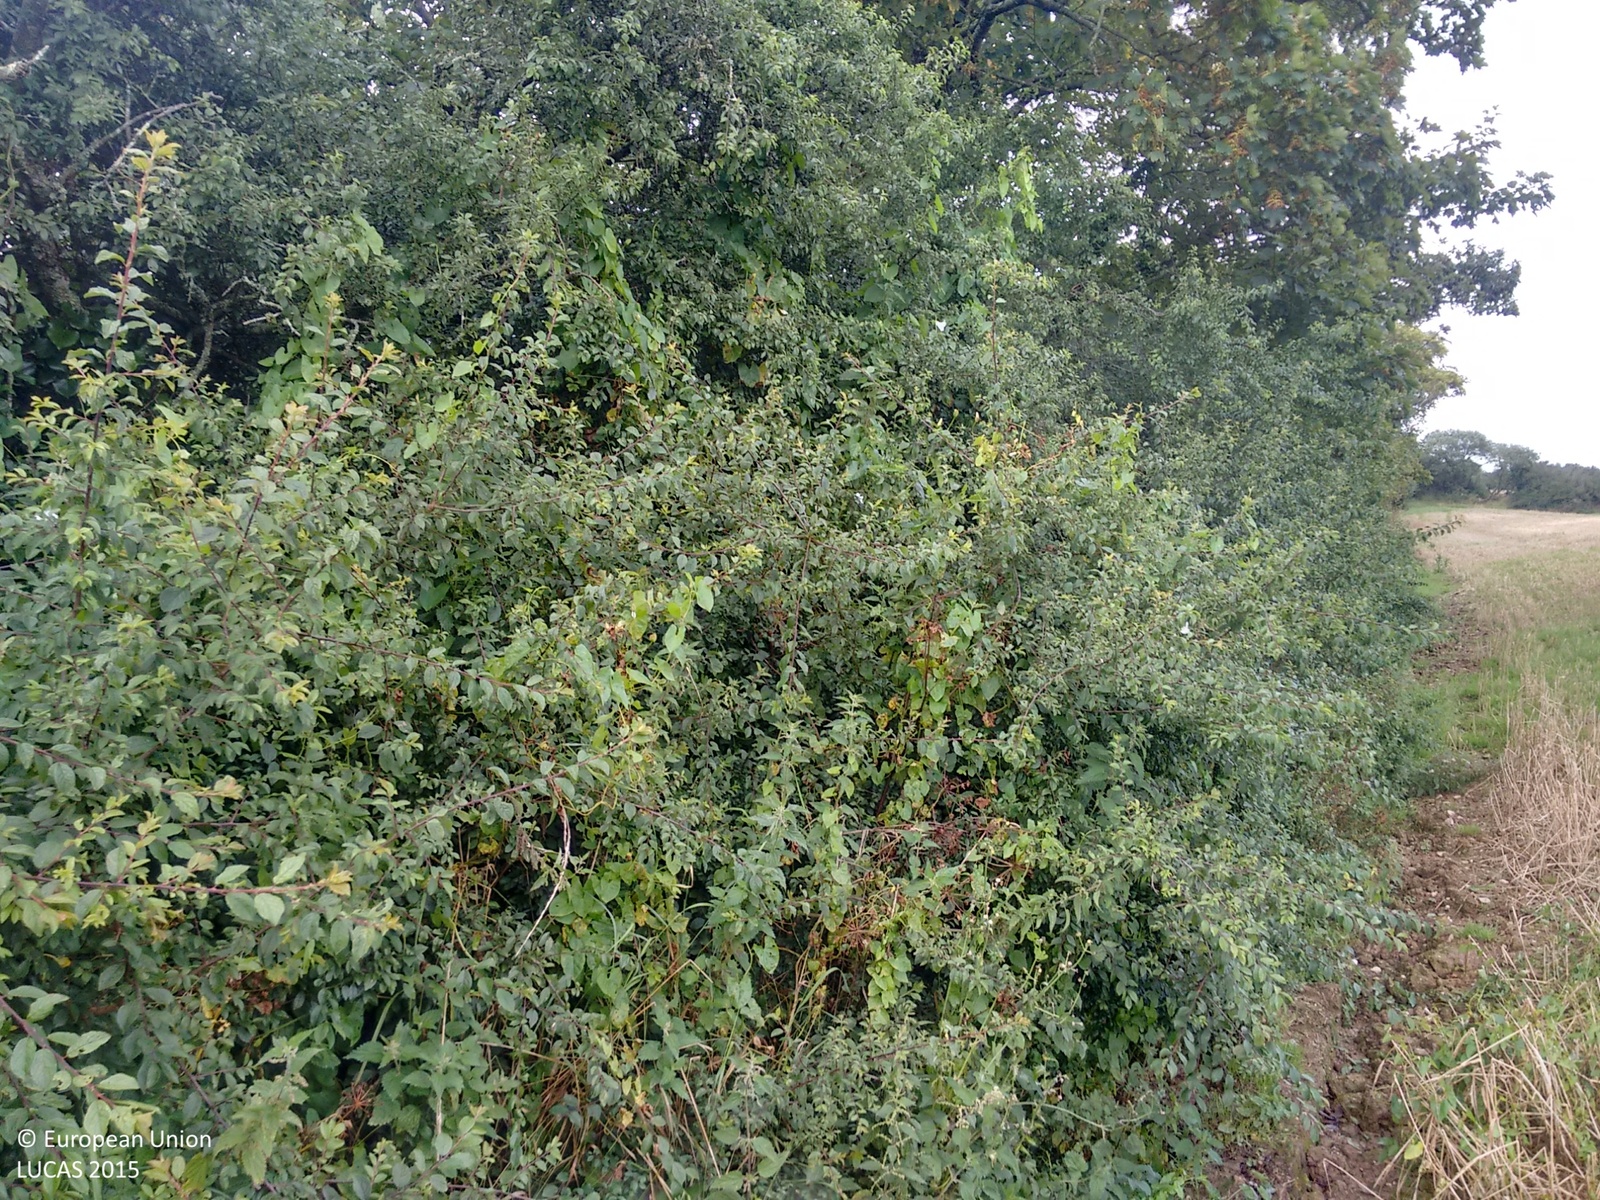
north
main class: Woodland
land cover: Broadleaved woodland
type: mesophytic deciduous forest
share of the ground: > 75 %
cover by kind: broadleaved forest trees 100 %
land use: Agriculture (excluding fallow land and kitchen gardens)
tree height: > 5 m
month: August
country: GB
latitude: 50.0655
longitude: -5.2509
